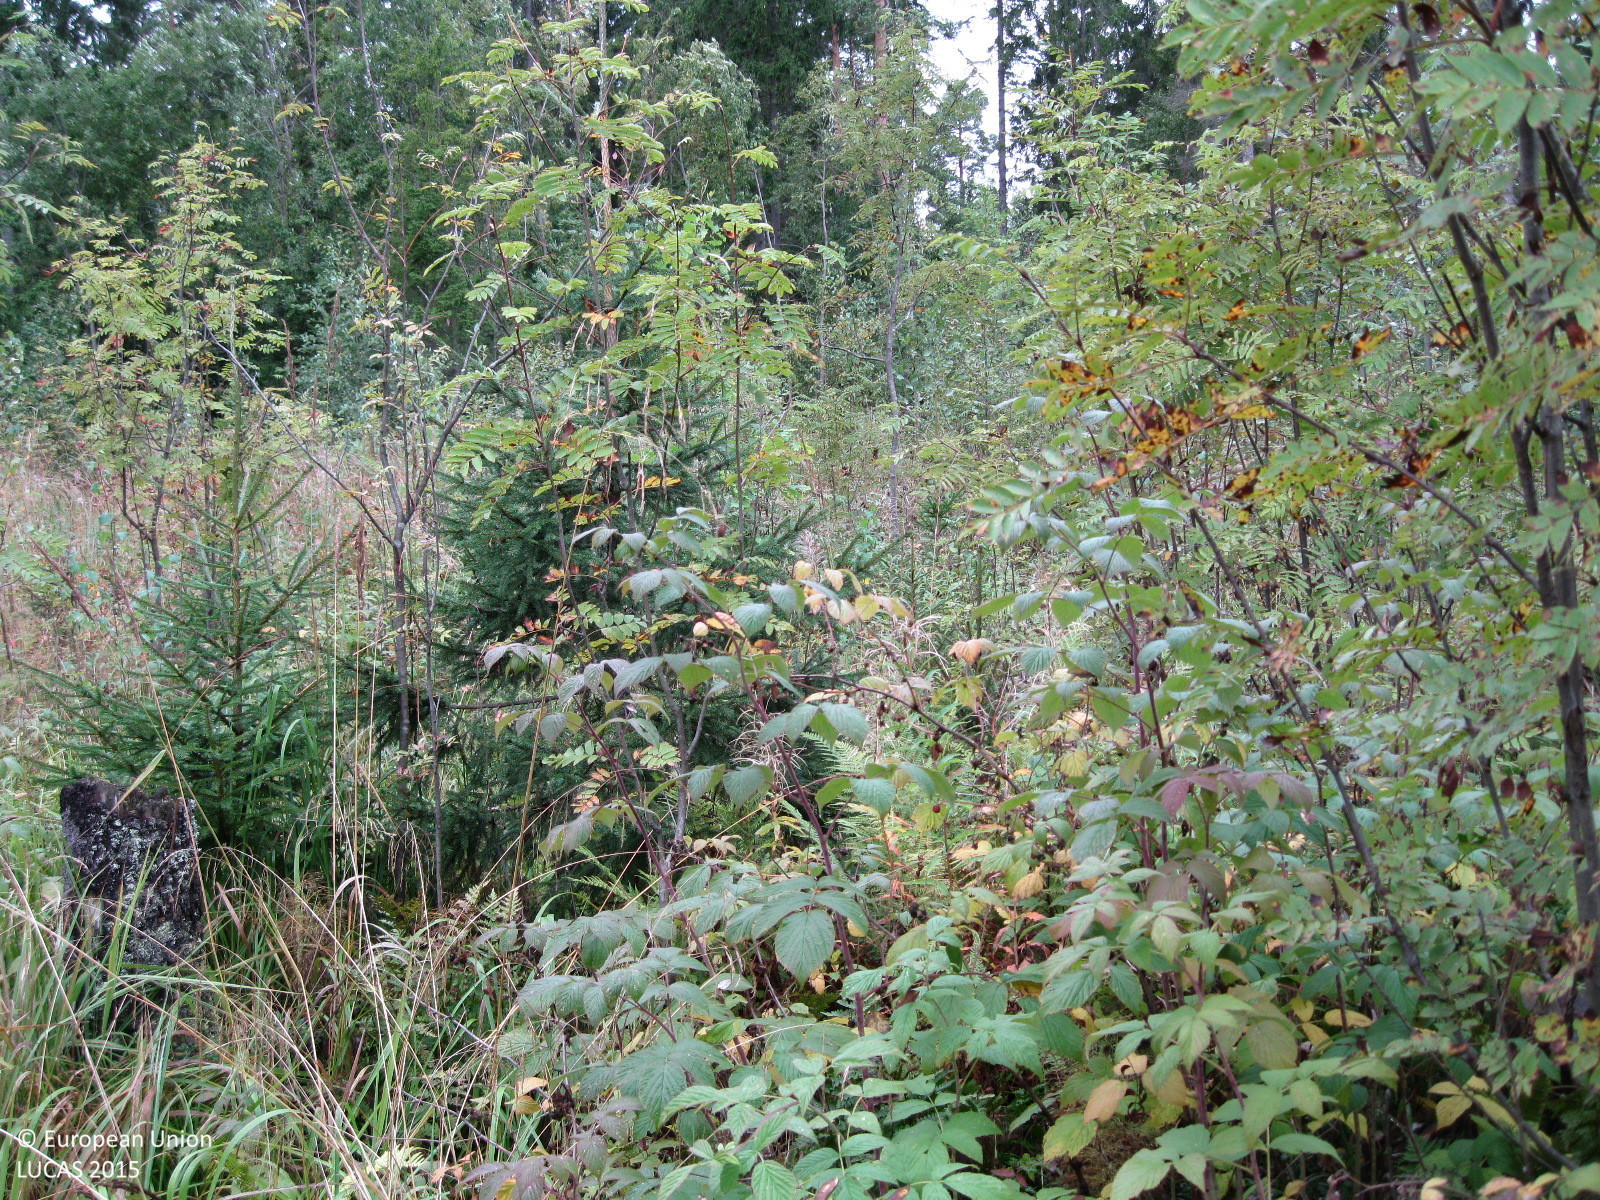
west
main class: Woodland
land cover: Broadleaved woodland
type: boreal forest
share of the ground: > 75 %
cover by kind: broadleaved forest trees 65 %, herbaceous plants 15 %, coniferous forest trees 10 %, shrubs 10 %
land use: Forestry
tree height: > 5 m
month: September
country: FI
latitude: 60.4816
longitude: 24.7592
